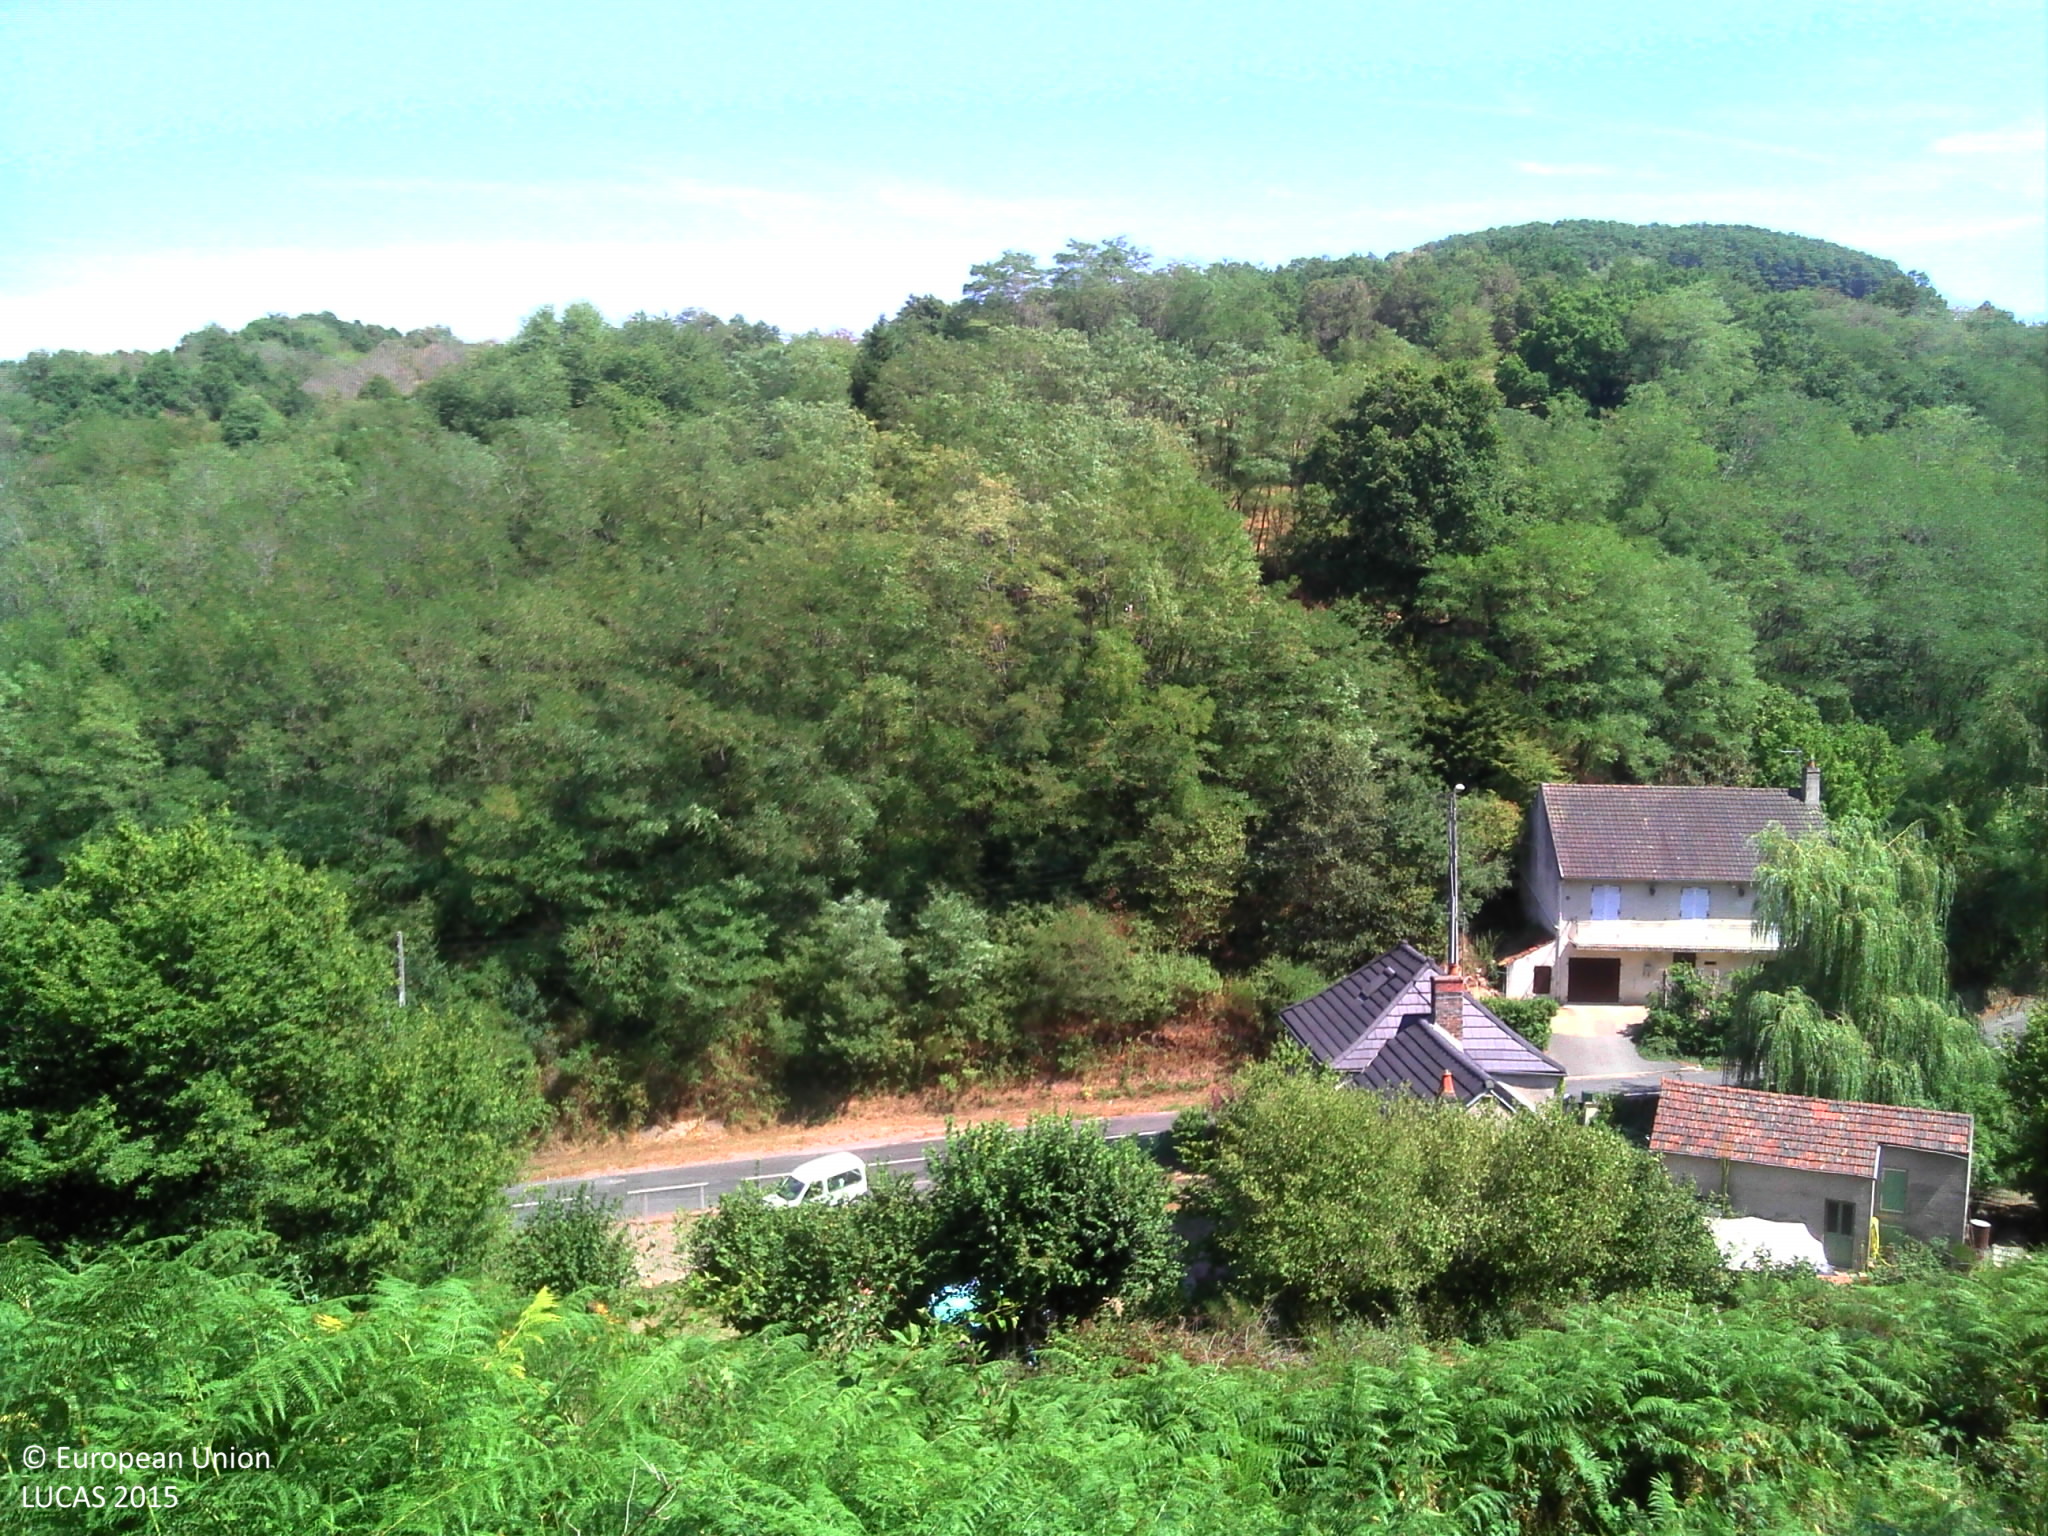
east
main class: Grassland
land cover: Spontaneously vegetated surfaces
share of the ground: > 75 %
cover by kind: herbaceous plants 95 %, shrubs 5 %
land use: Semi-natural and natural areas not in use
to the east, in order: Spontaneously vegetated surfaces; Shrubland without tree cover; Abandoned hedges; Artificial constructions in urban areas; Broadleaved woodland; Grass margins; Paved roads, cycling and walking lanes; Grass margins; Broadleaved woodland; Fences; Grassland without tree/shrub cover; Abandoned hedges; Grassland without tree/shrub cover; Abandoned hedges; Grassland without tree/shrub cover
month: August
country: FR
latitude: 46.8198
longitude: 4.4299
